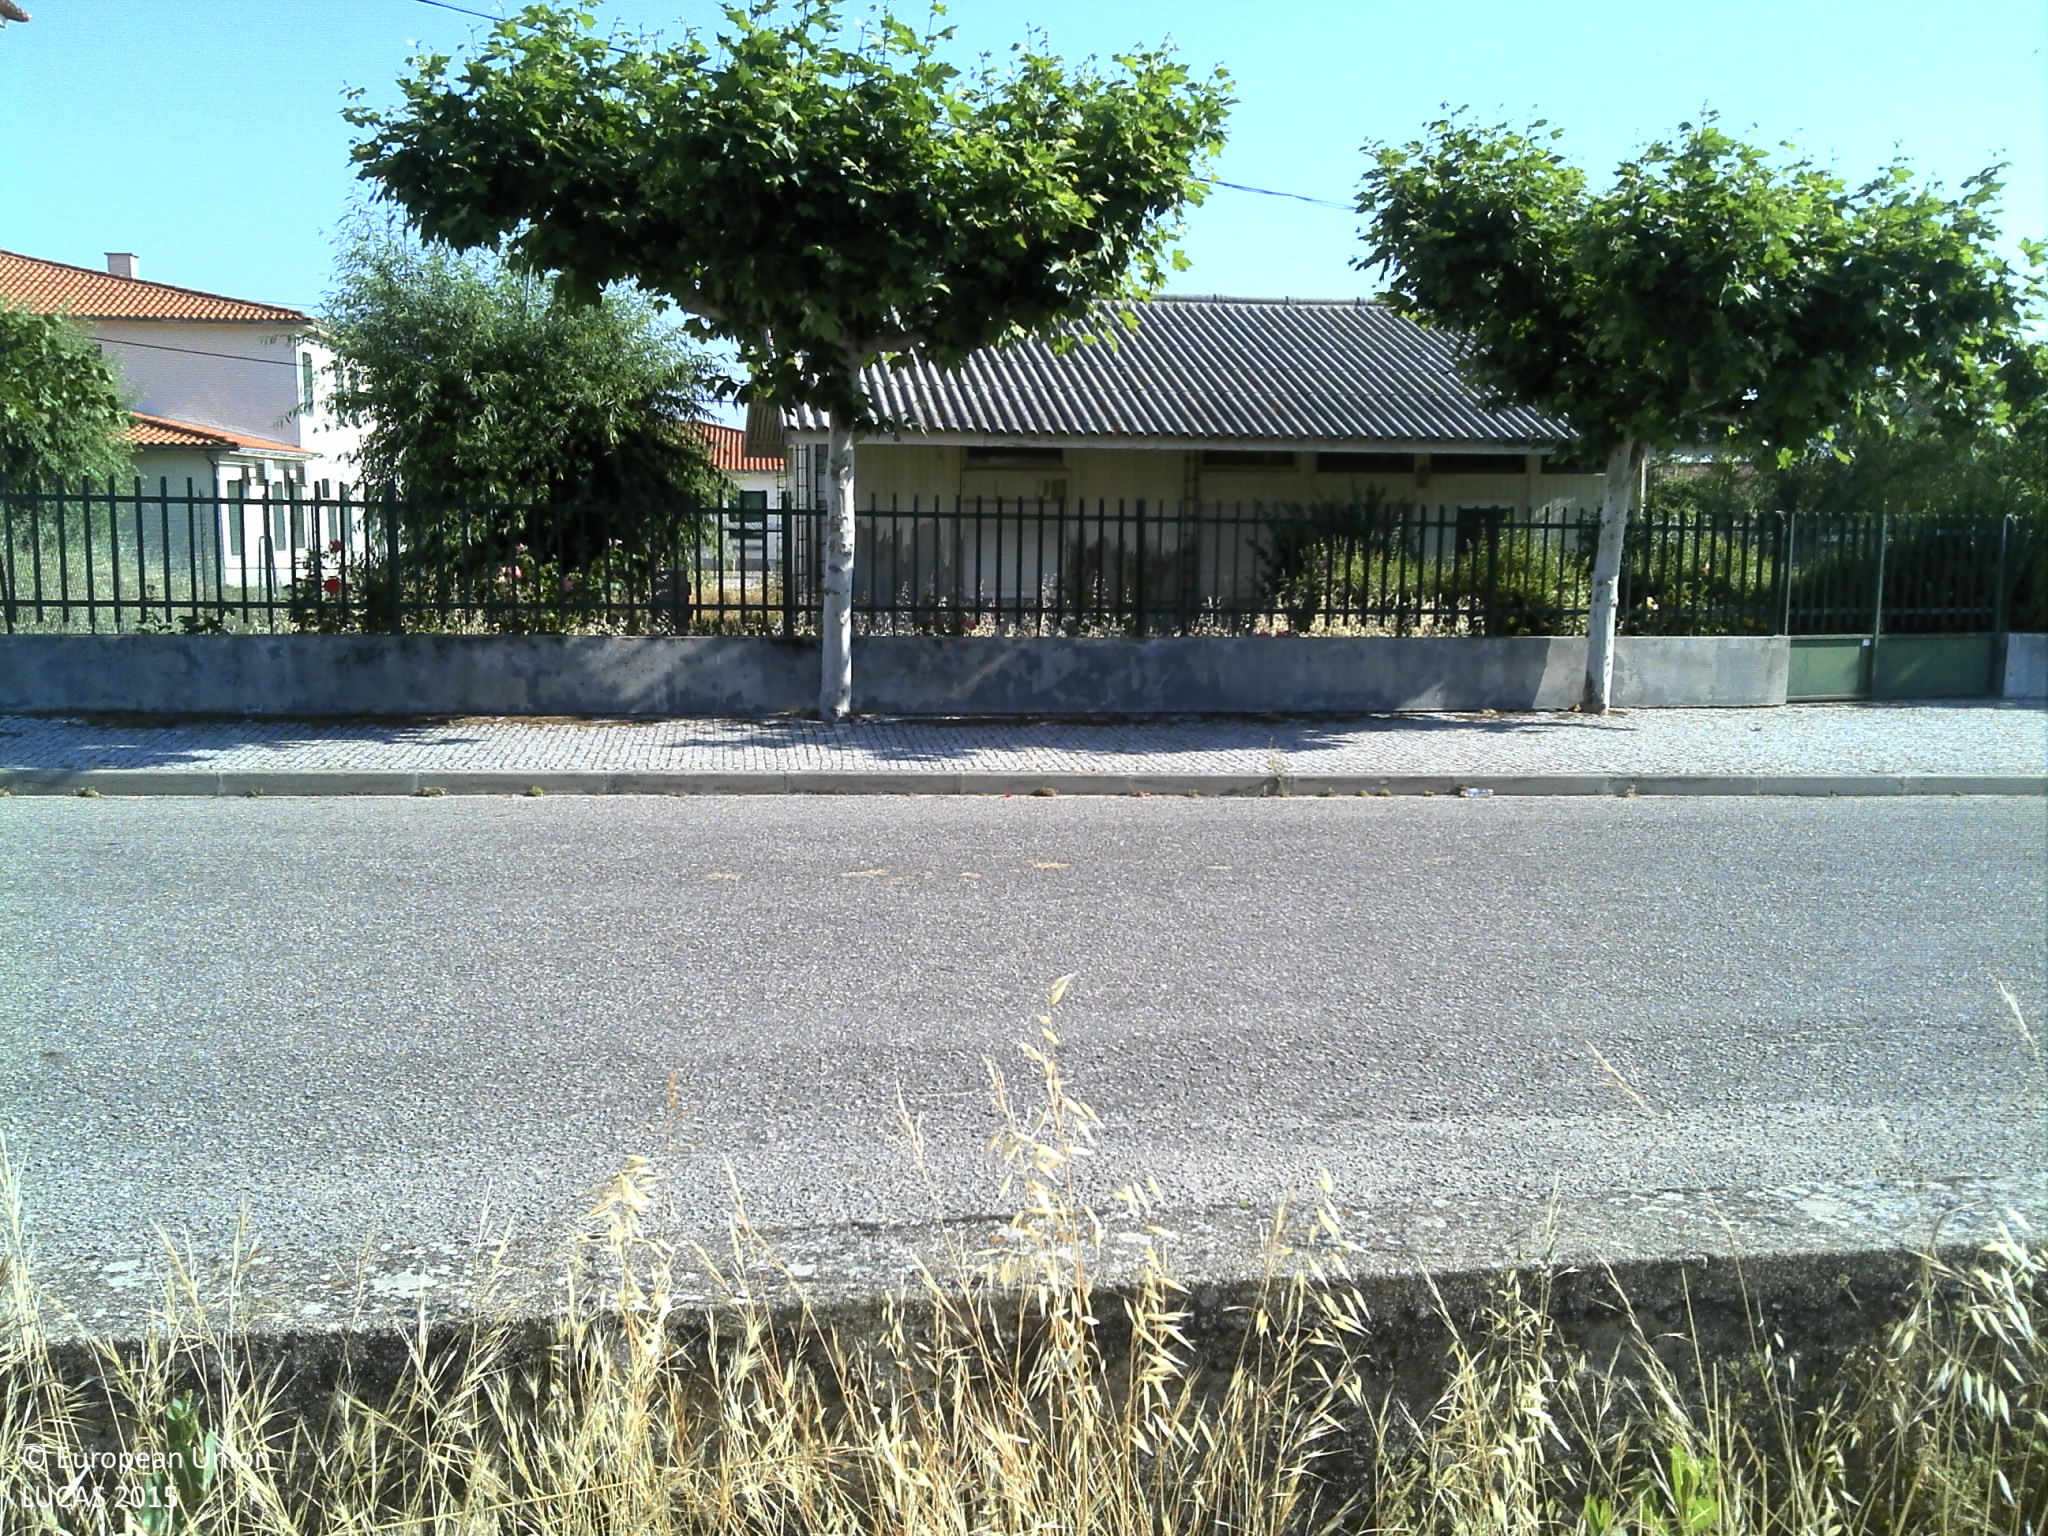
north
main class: Grassland
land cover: Spontaneously vegetated surfaces
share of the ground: > 75 %
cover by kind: herbaceous plants 100 %
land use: Fallow land
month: June
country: PT
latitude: 40.7245
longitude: -6.9001
